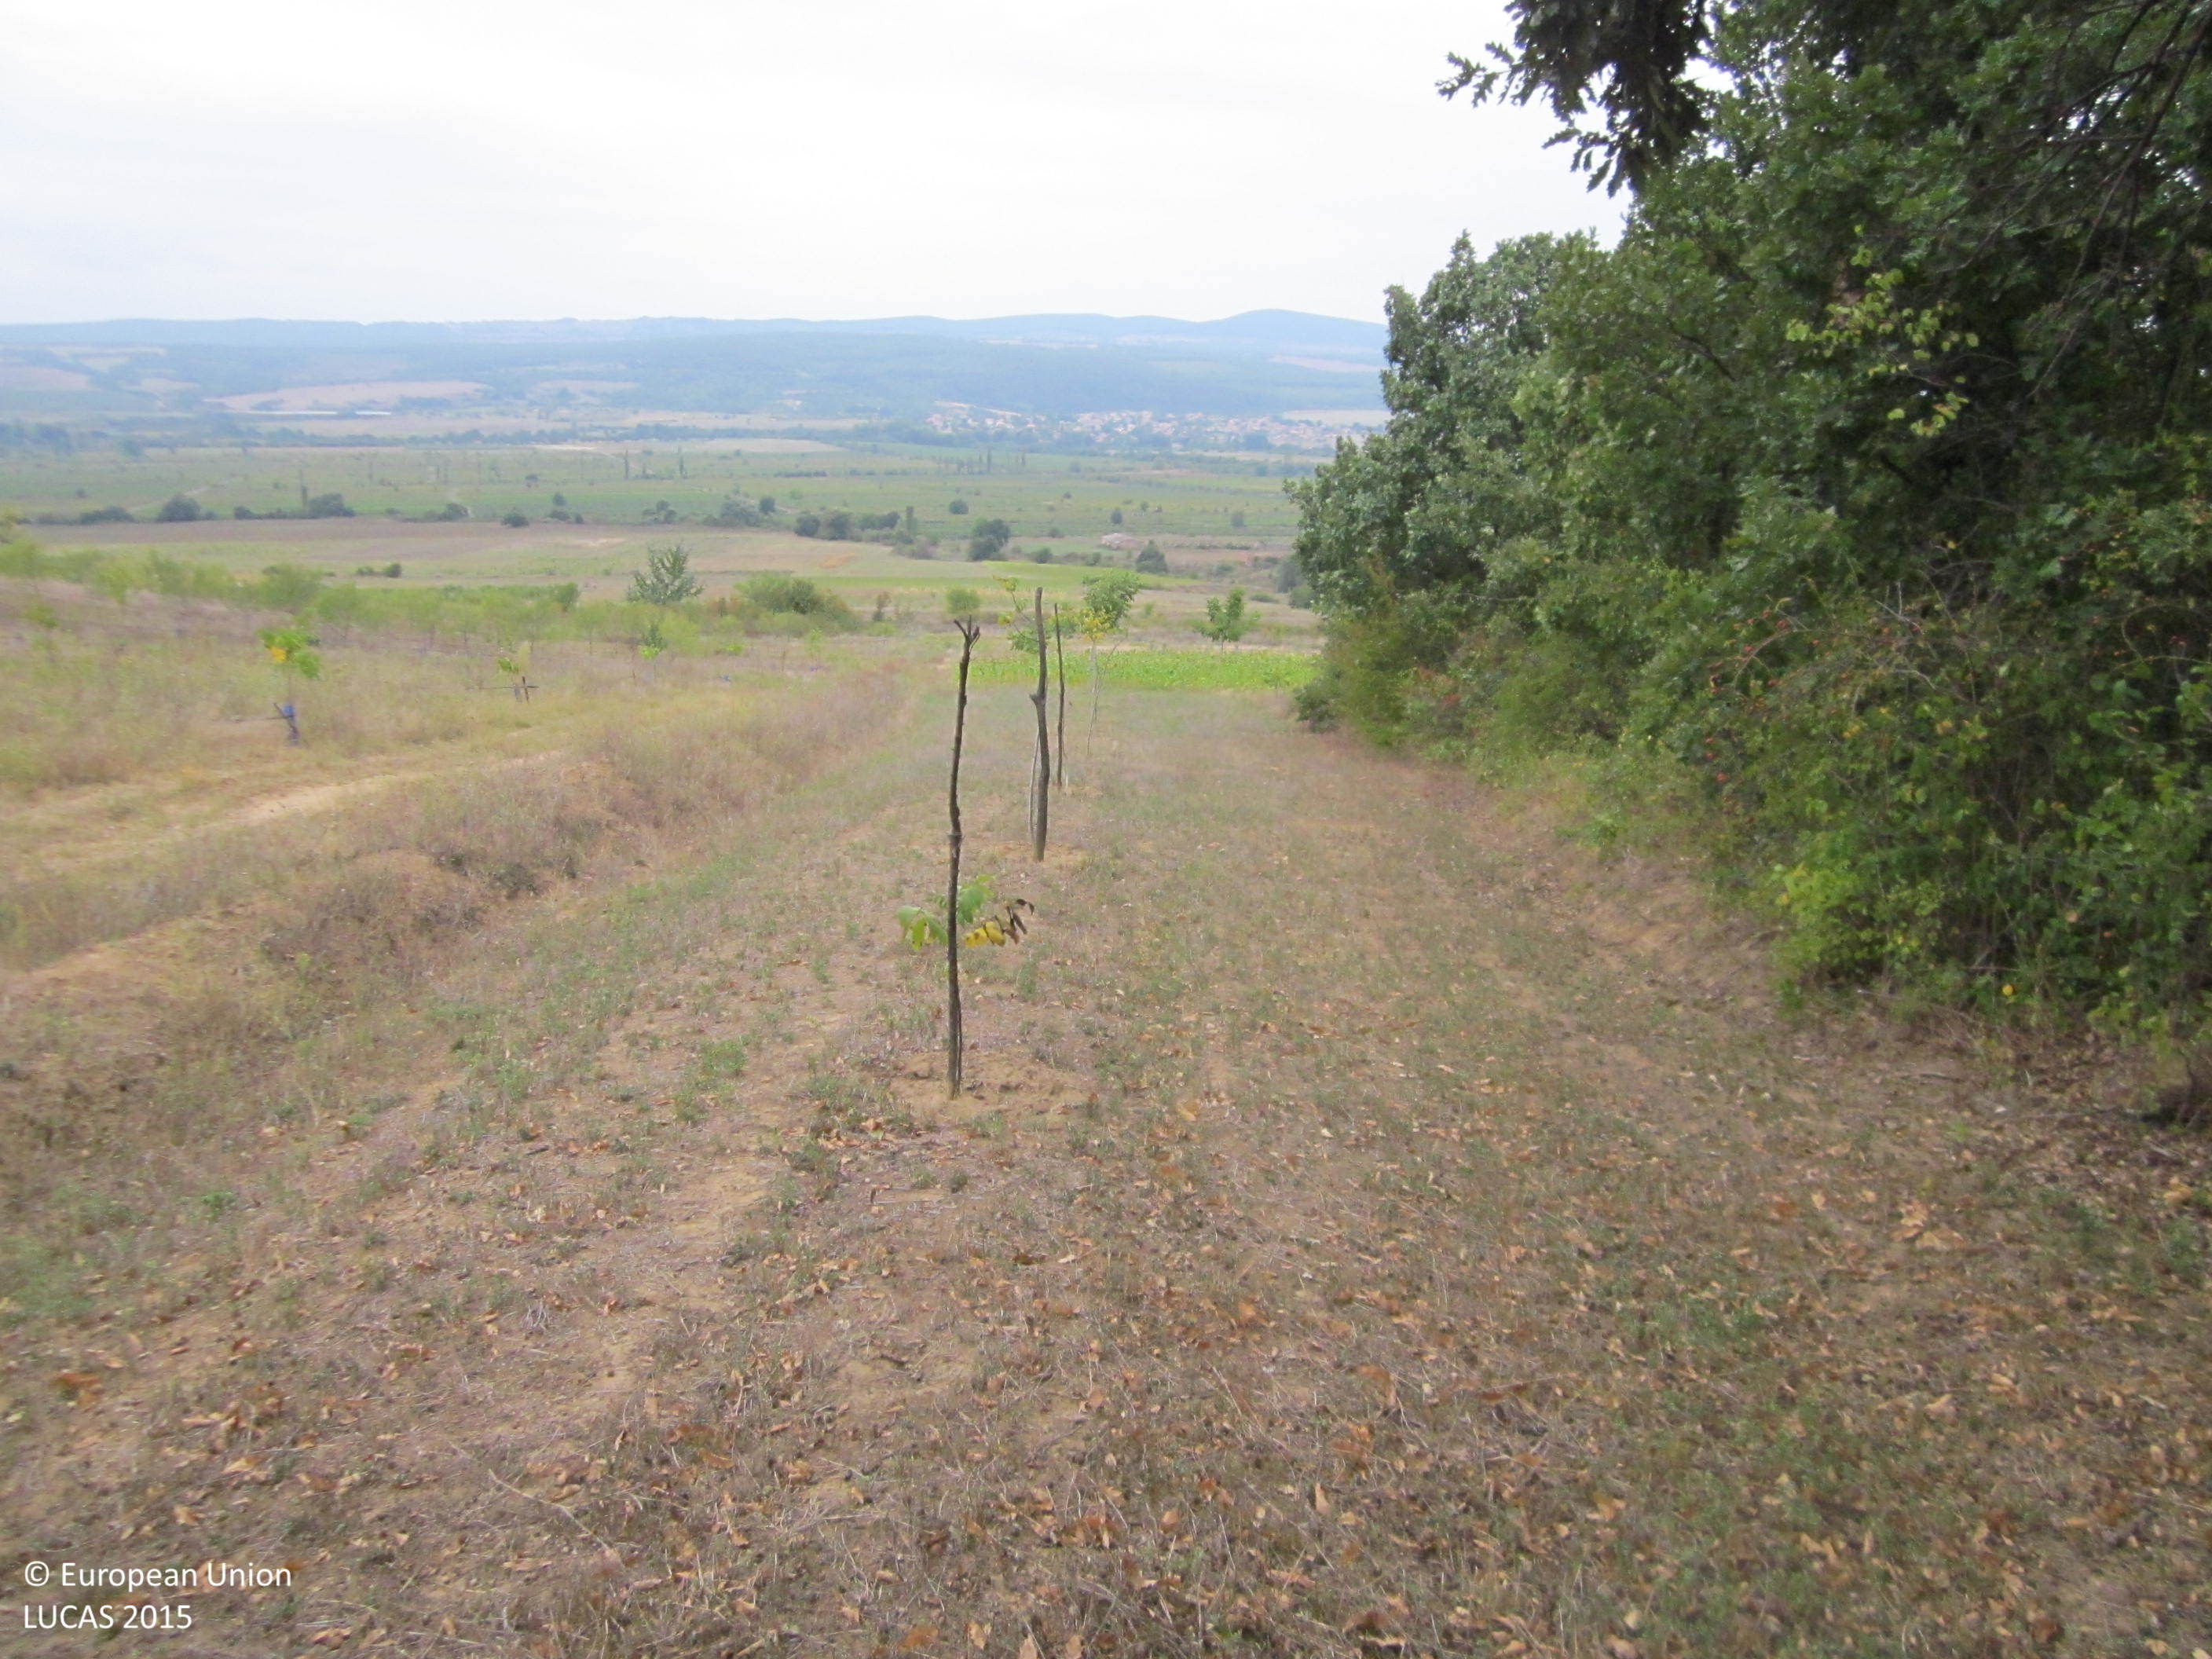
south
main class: Cropland
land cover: Nuts trees
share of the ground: 10 - 25 %
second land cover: Grassland without tree/shrub cover
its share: 25 - 50 %
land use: Agriculture (excluding fallow land and kitchen gardens)
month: September
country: BG
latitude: 42.8114
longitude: 27.3995
